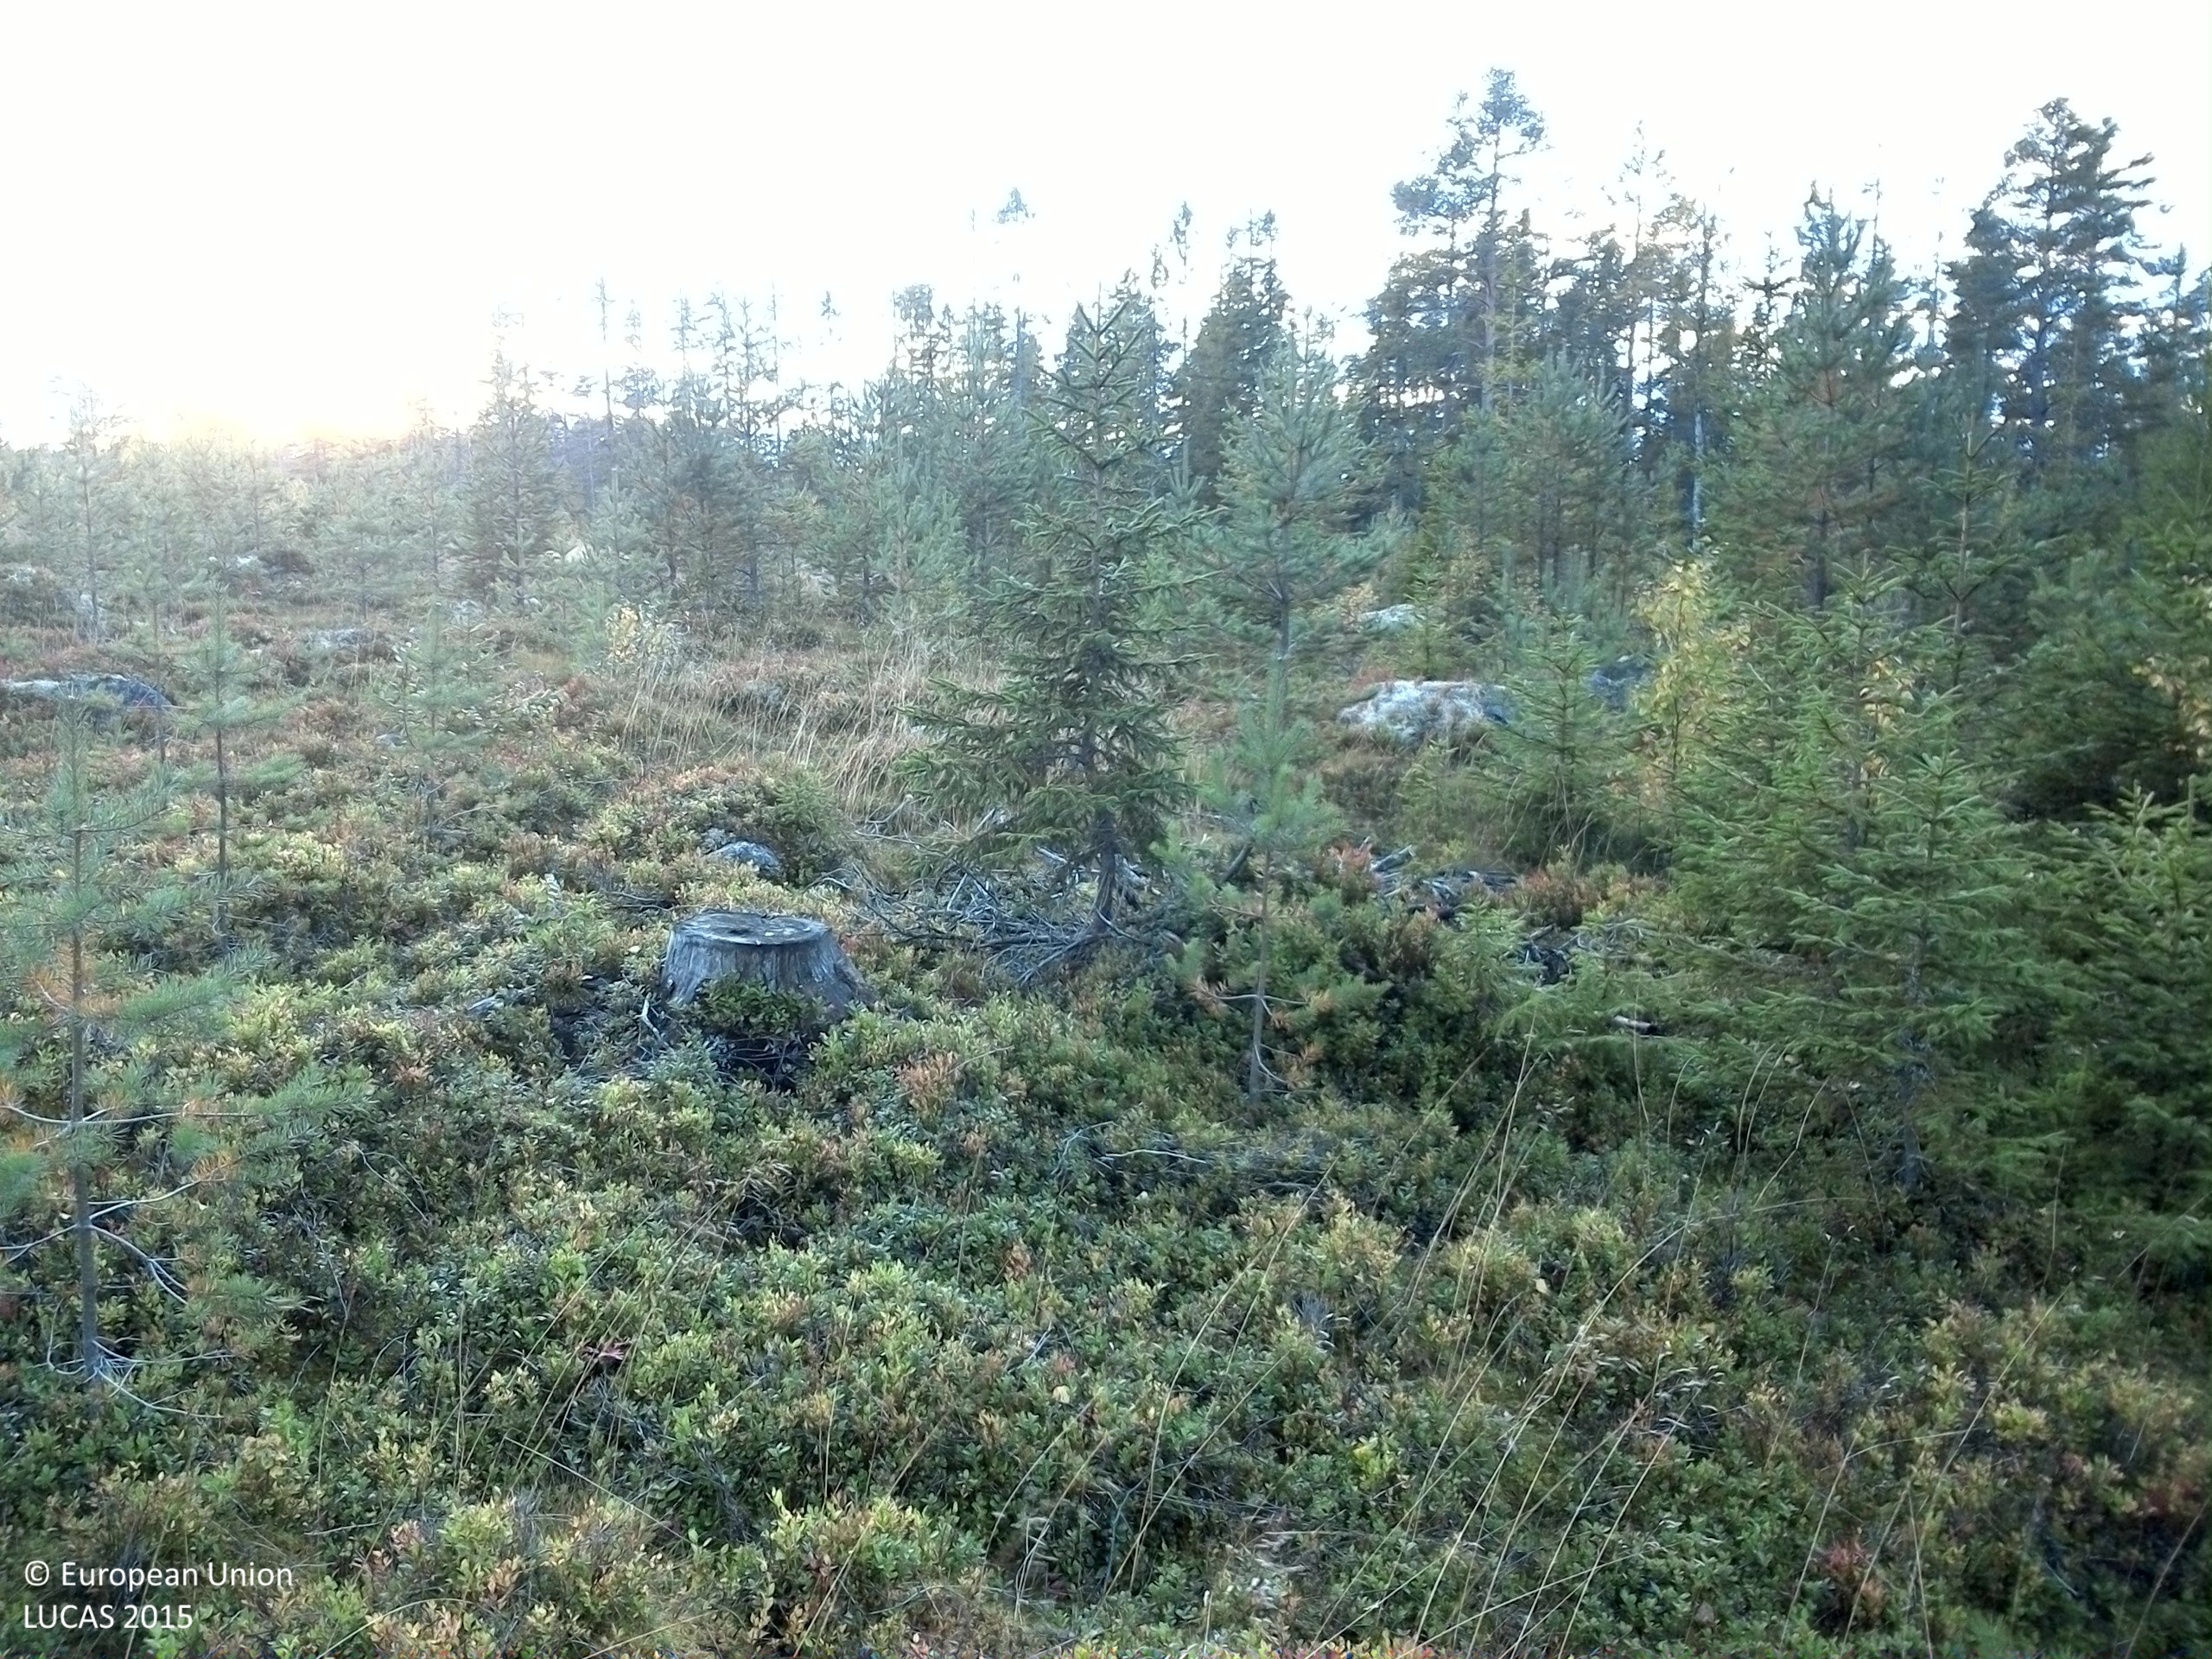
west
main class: Woodland
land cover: Other coniferous woodland
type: boreal forest
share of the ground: 10 - 25 %
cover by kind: shrubs 50 %, coniferous forest trees 25 %, lichens and mosses 20 %, herbaceous plants 5 %
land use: Forestry
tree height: < 5 m
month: September
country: SE
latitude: 61.3982
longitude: 15.3212
